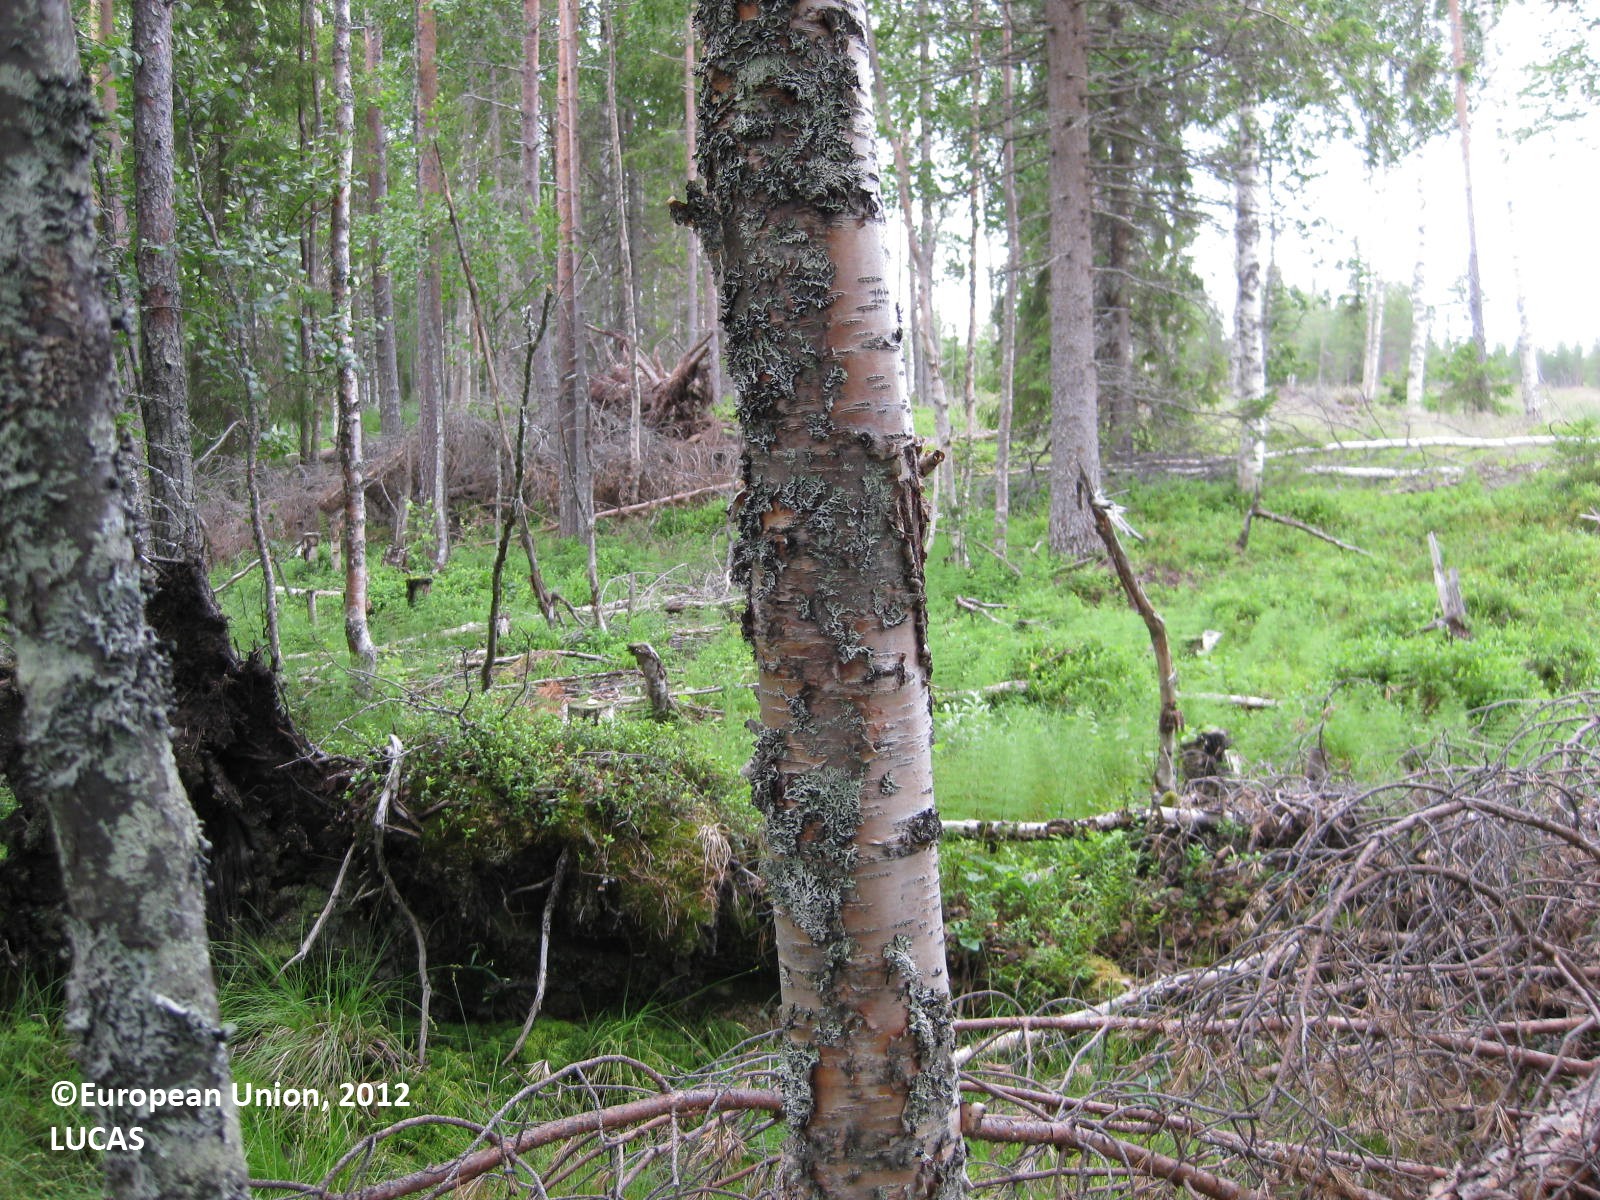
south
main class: Woodland
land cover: Pine dominated mixed woodland
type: boreal forest
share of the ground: > 75 %
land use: Forestry
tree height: > 5 m
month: July
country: FI
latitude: 65.9063
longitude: 29.6707
